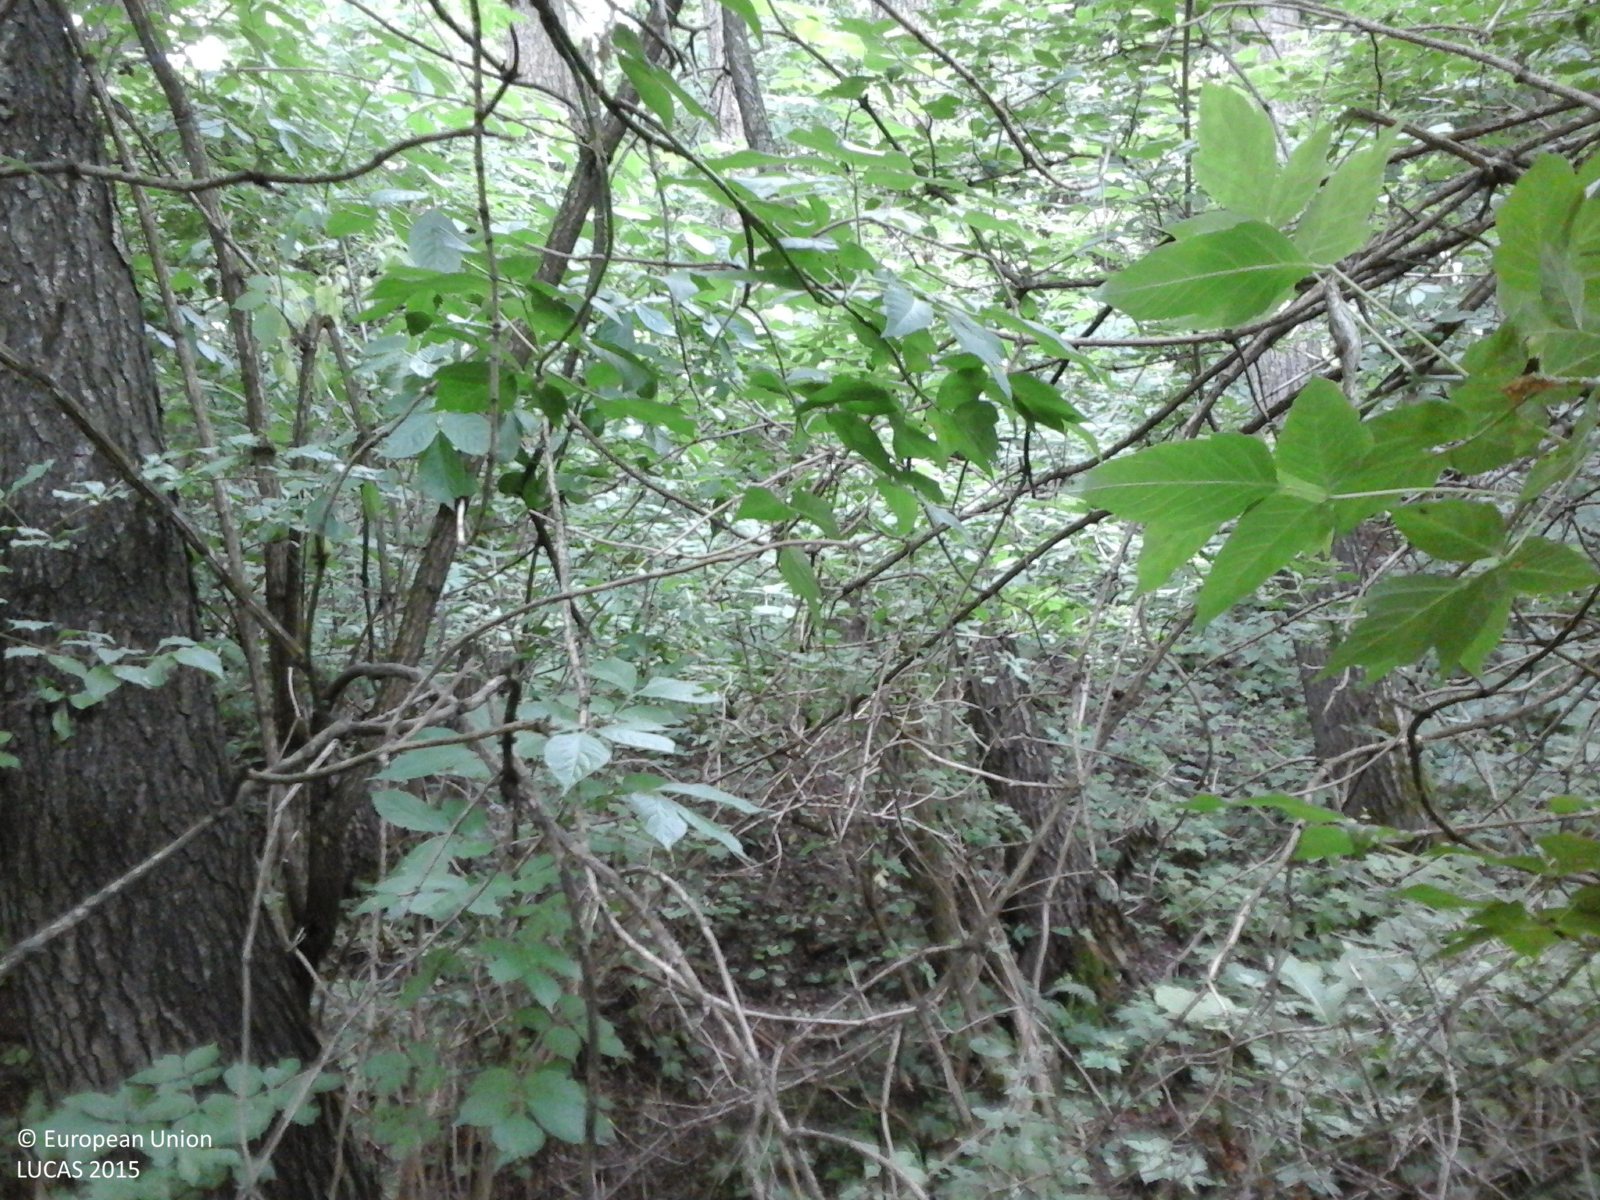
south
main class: Woodland
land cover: Broadleaved woodland
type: non-riverine alder, birch or aspen forest
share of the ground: > 75 %
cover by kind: broadleaved forest trees 100 %
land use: Forestry
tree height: > 5 m
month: June
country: RO
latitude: 47.4806
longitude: 26.3952
